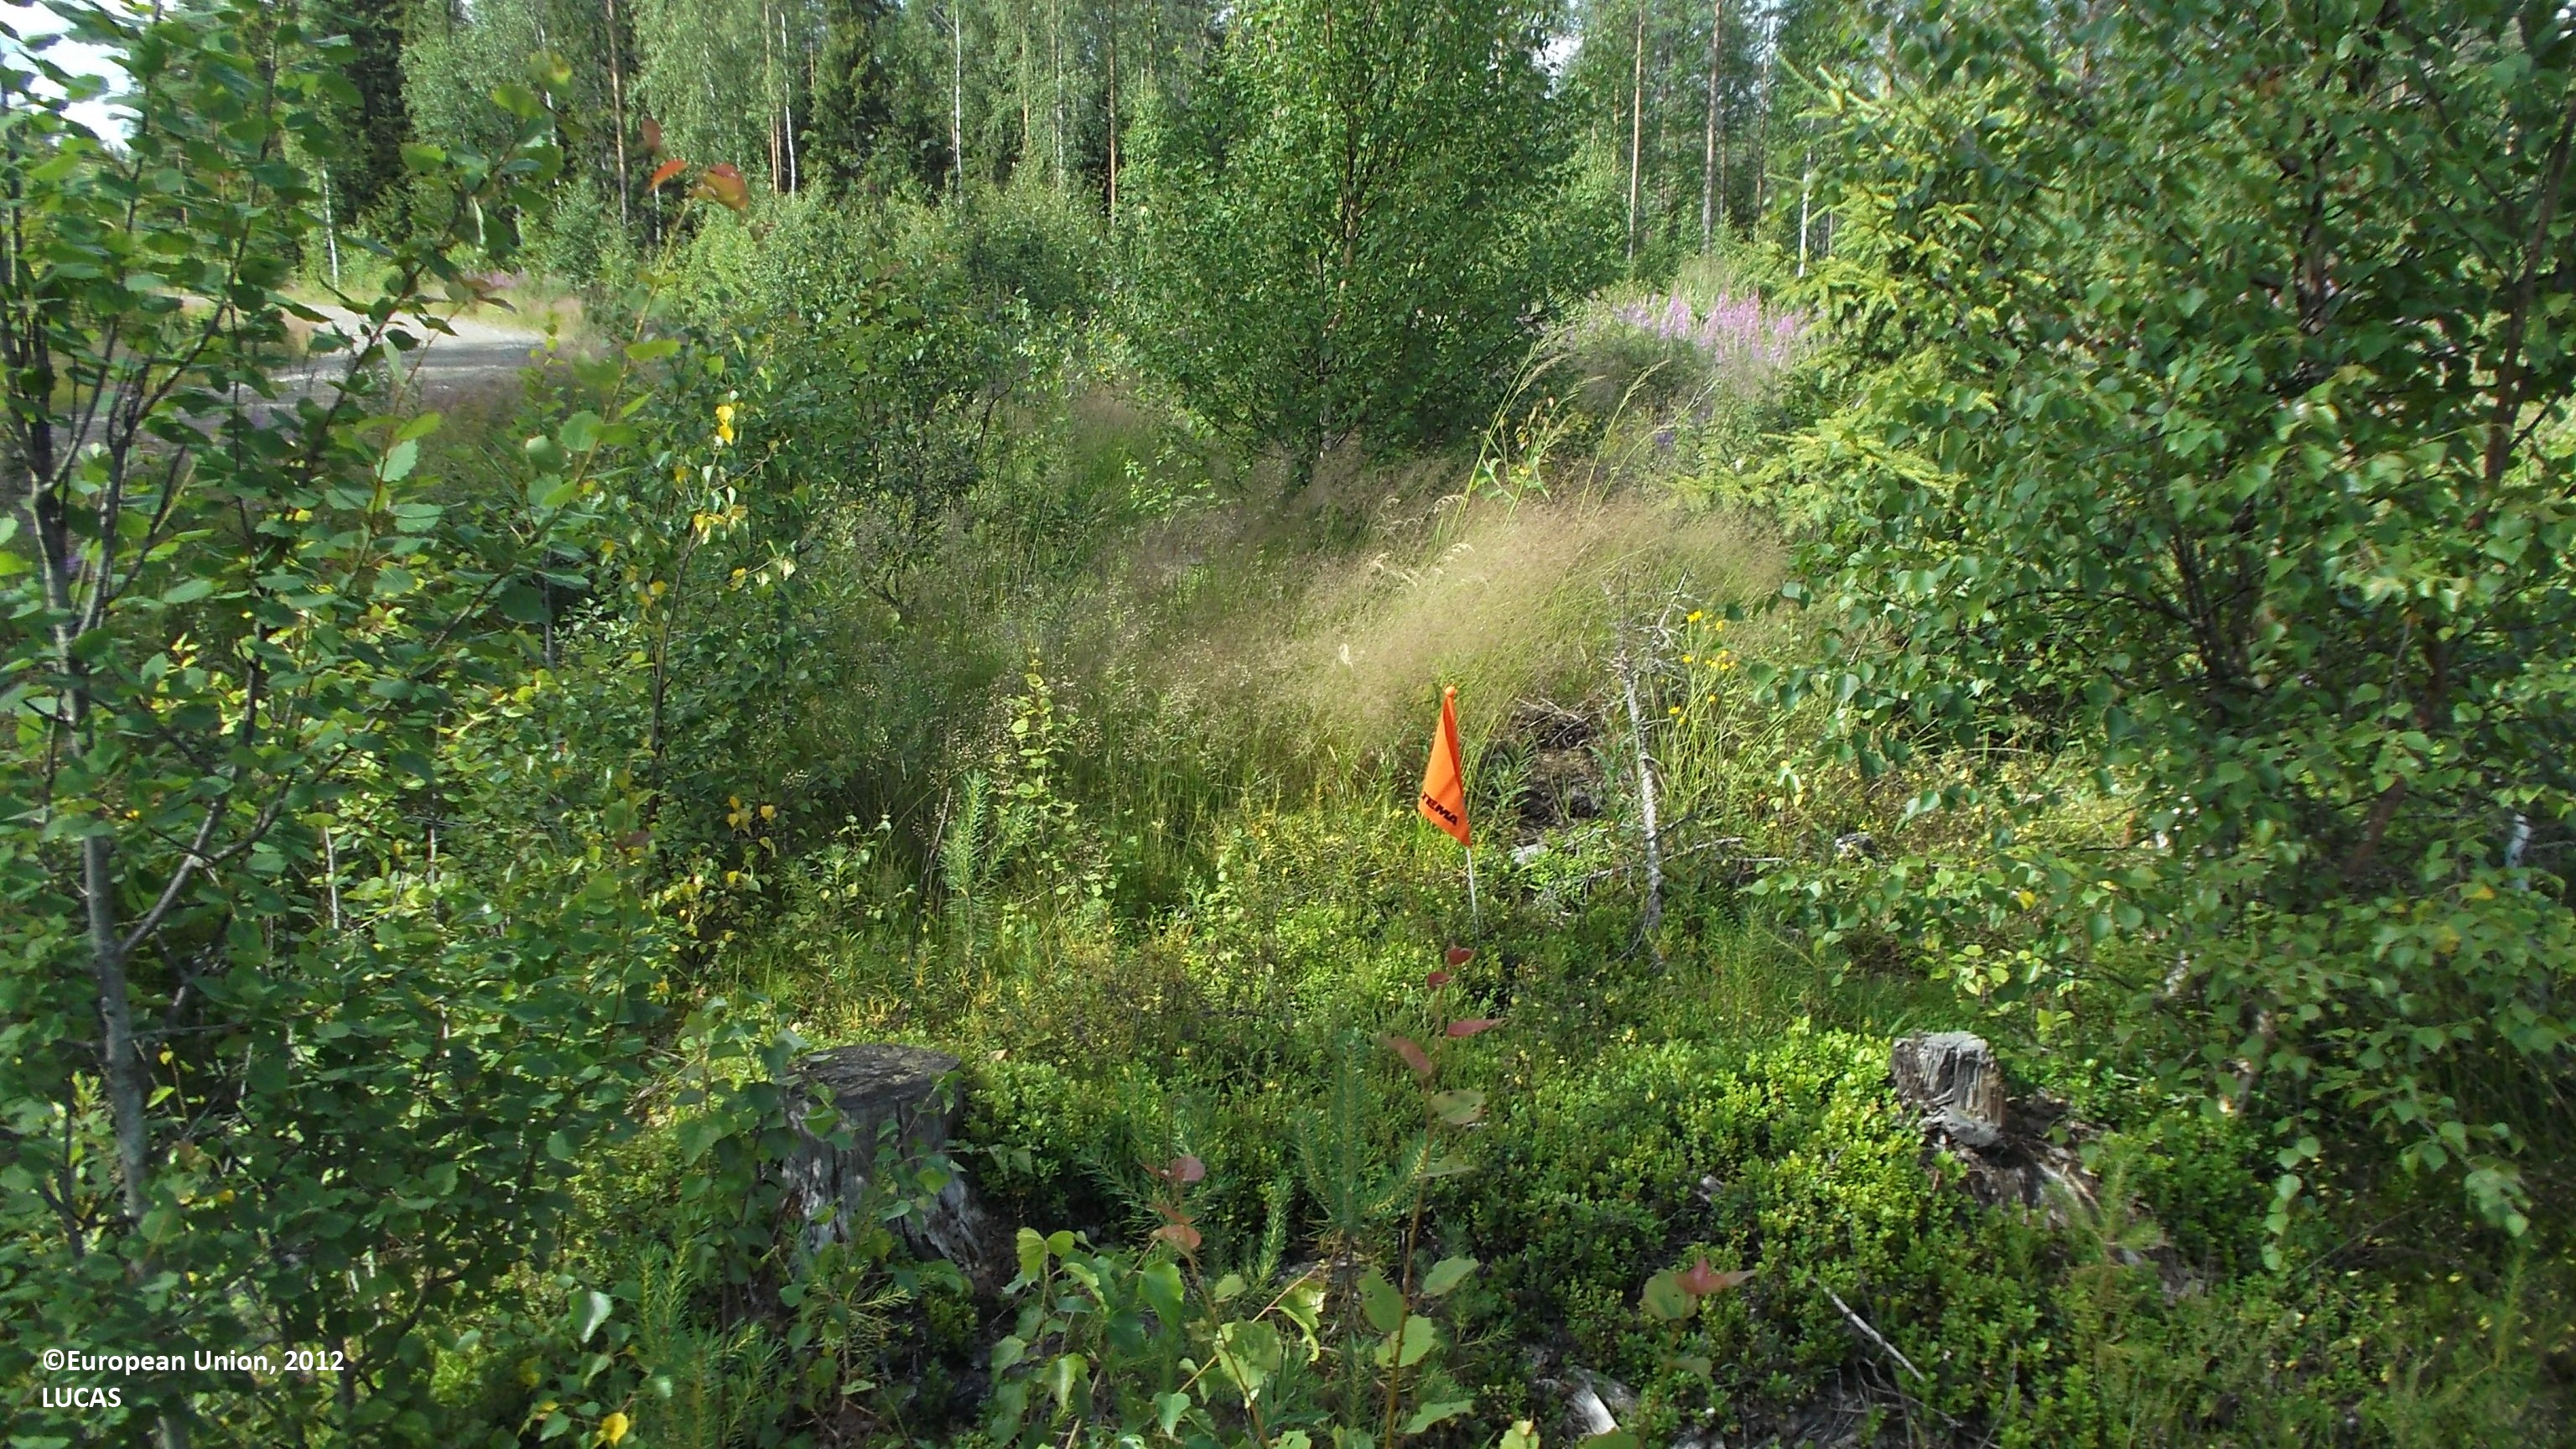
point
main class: Grassland
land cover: Grassland with sparse tree/shrub cover
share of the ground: 25 - 50 %
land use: Forestry
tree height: < 5 m
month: July
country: FI
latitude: 63.2977
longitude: 23.7720
